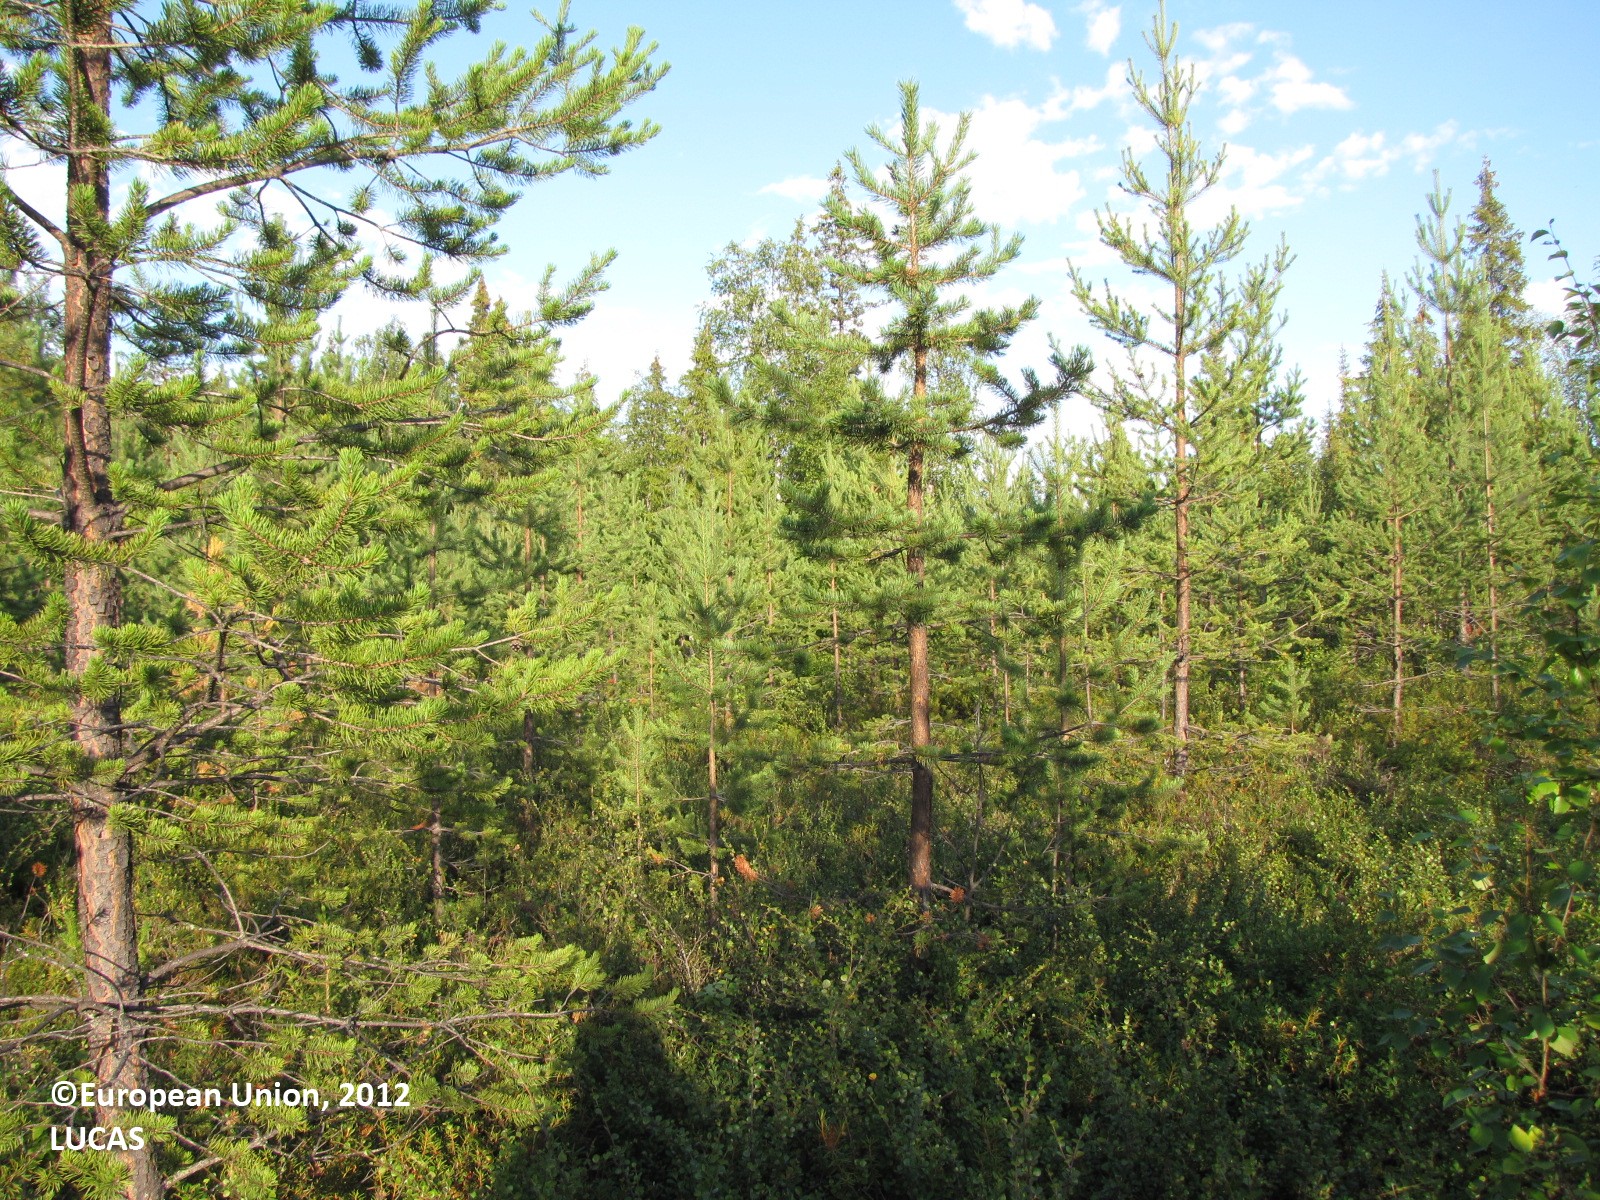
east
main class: Woodland
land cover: Pine dominated coniferous woodland
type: boreal forest
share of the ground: 50 - 75 %
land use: Forestry
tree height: < 5 m
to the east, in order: Pine dominated coniferous woodland; Tracks; Spruce dominated mixed woodland; Broadleaved woodland
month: July
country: FI
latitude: 66.7013
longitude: 24.4740
